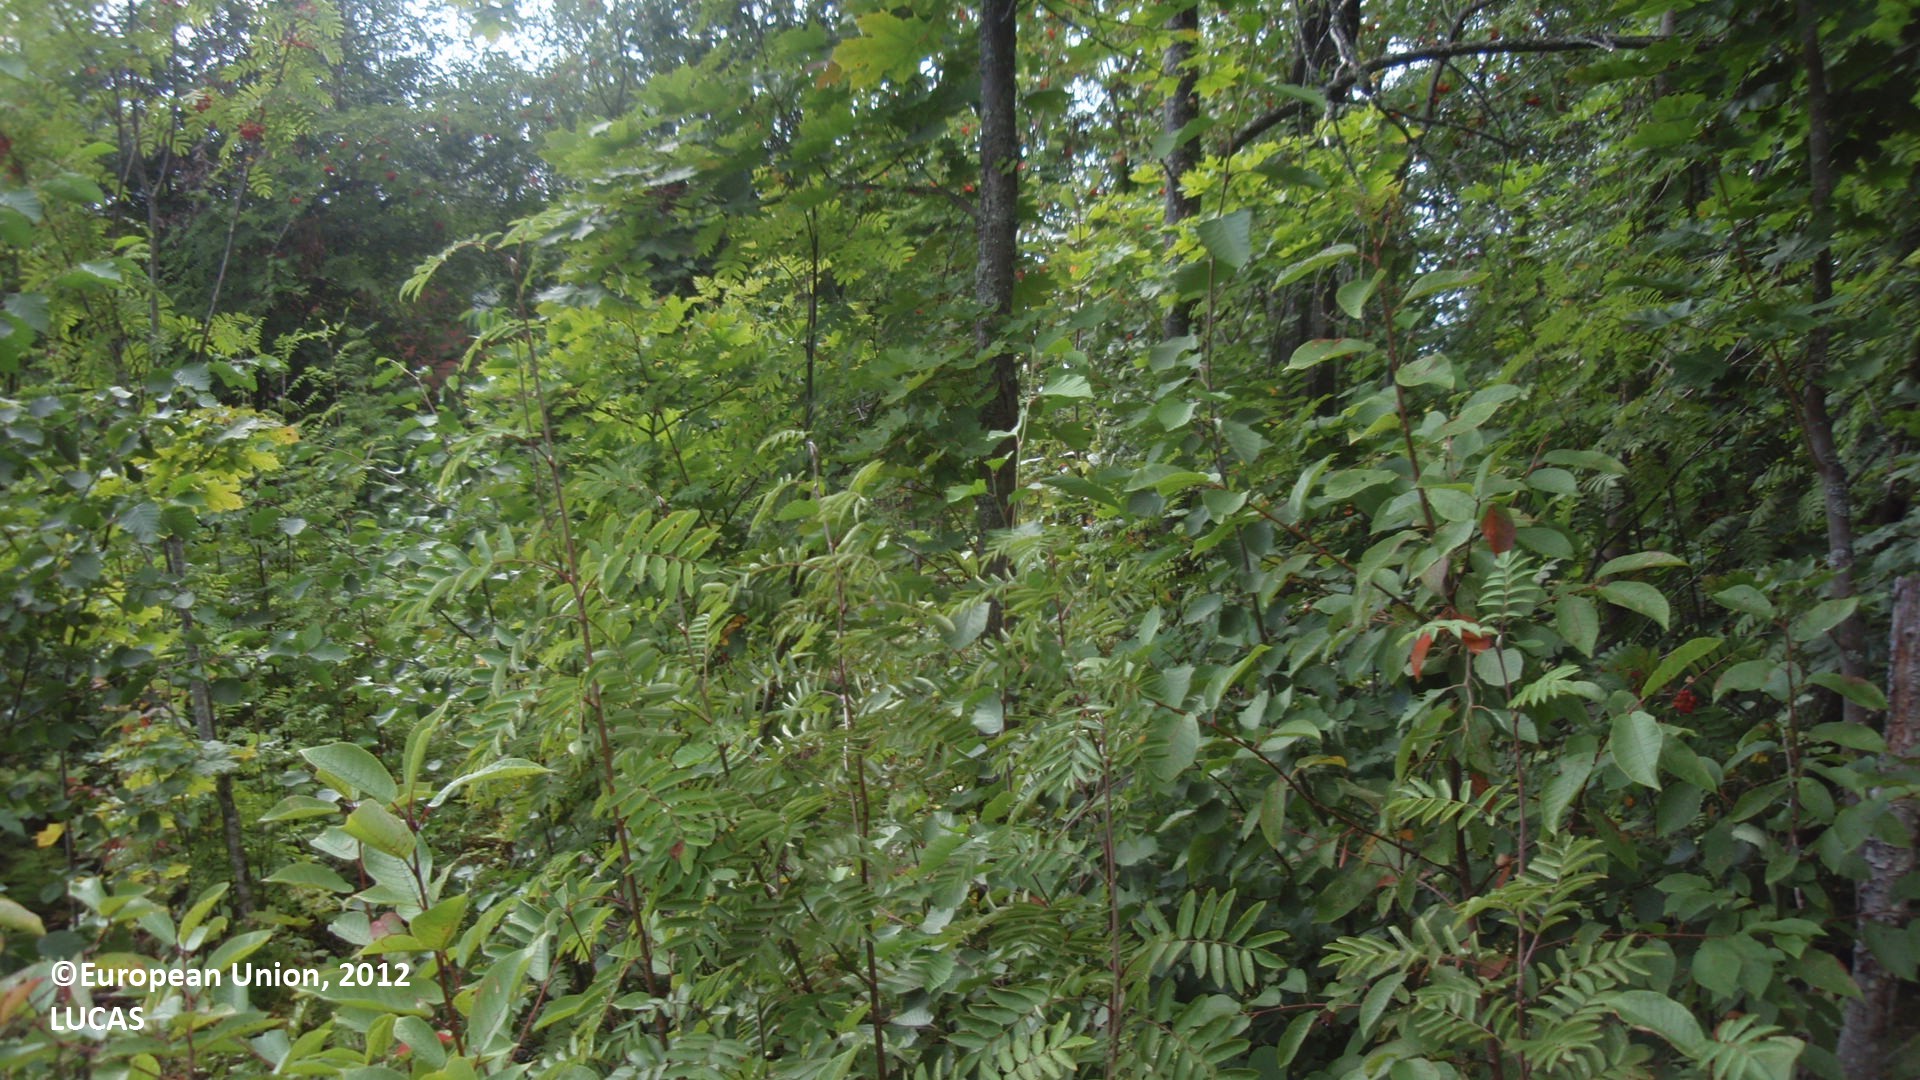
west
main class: Woodland
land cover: Broadleaved woodland
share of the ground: > 75 %
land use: Forestry
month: August
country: FI
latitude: 60.8843
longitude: 26.6085
